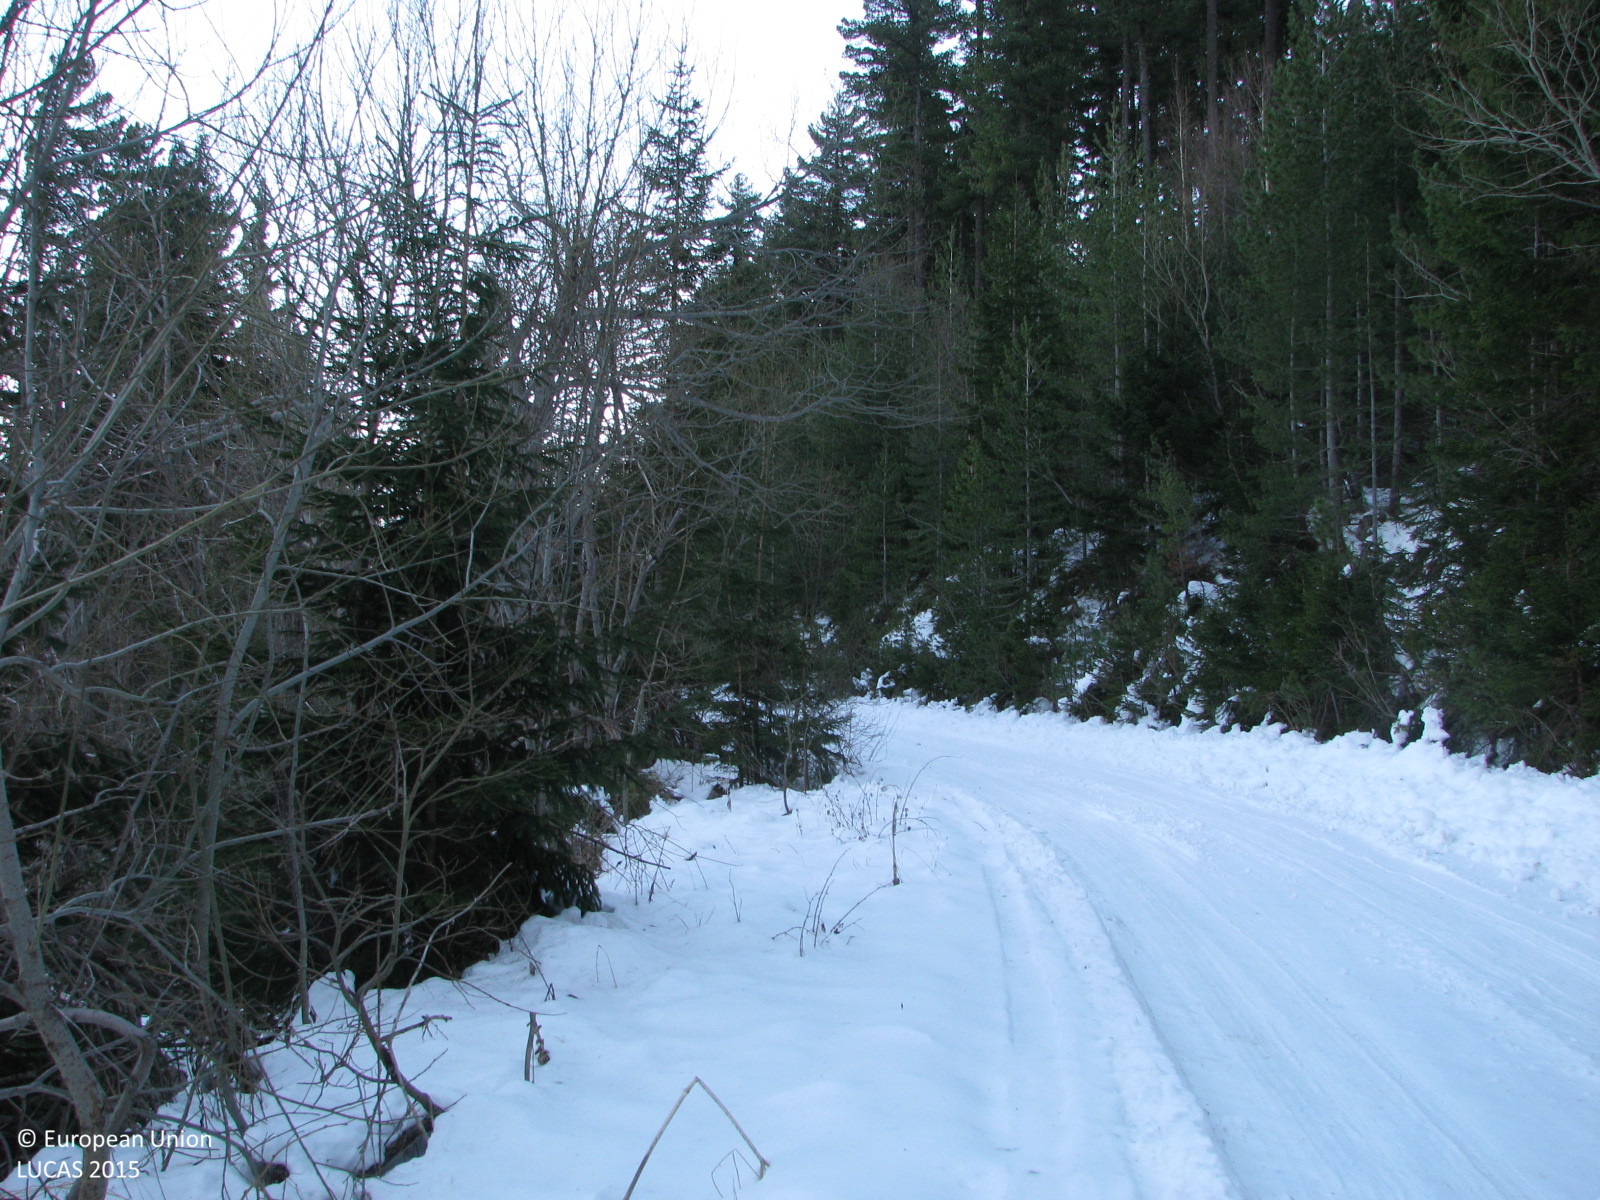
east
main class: Woodland
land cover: Spruce dominated mixed woodland
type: hemiboreal forest and nemoral coniferous forest and mixed broadleaved-coniferous forest
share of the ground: > 75 %
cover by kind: coniferous forest trees 60 %, broadleaved forest trees 25 %, unconsolidated bare surface 15 %
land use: Forestry
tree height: < 5 m
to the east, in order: Spruce dominated mixed woodland; Tracks; Spruce dominated mixed woodland; Spruce dominated coniferous woodland
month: December
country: BG
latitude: 42.1942
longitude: 23.8296
